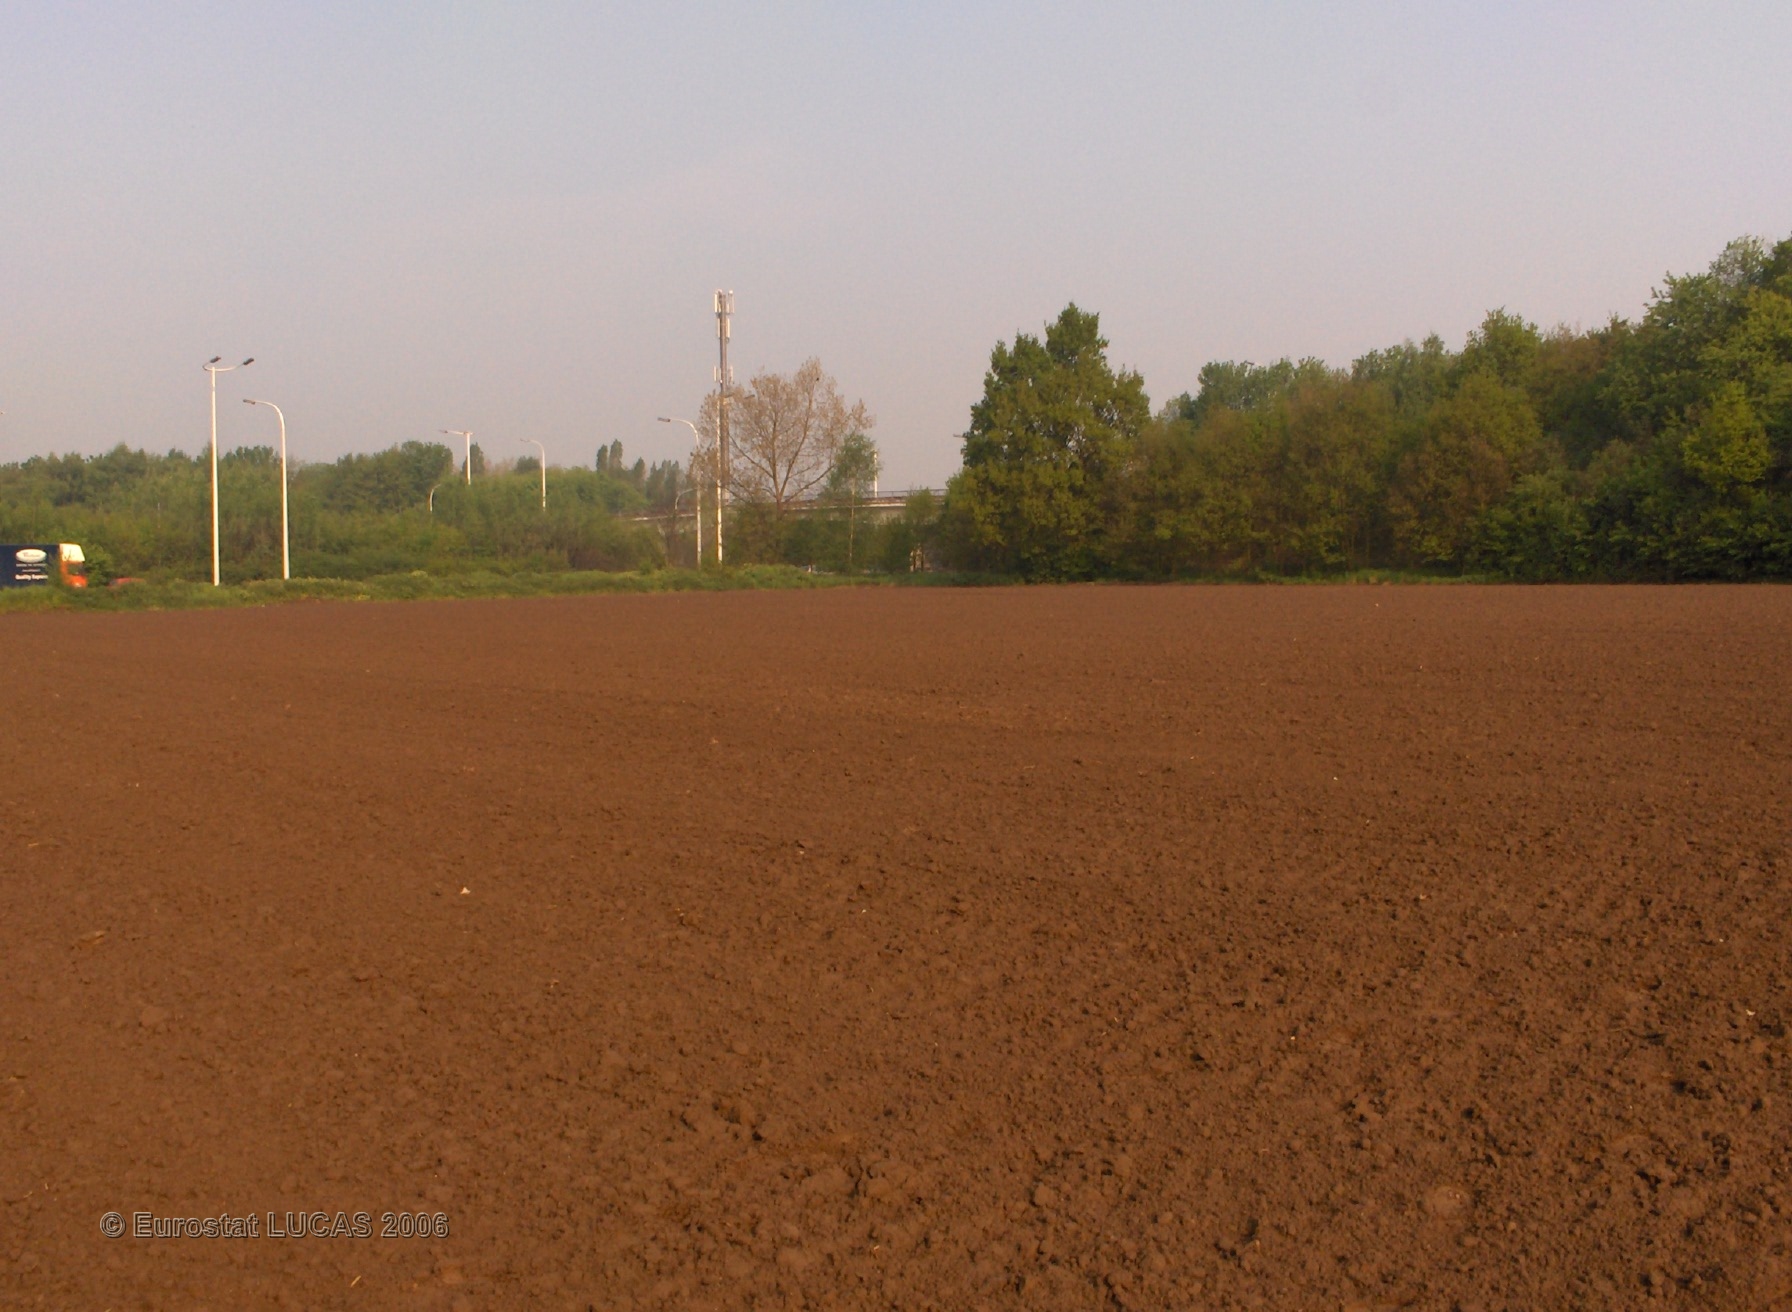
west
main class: Cropland
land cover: Maize
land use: Agriculture (excluding fallow land and kitchen gardens)
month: May
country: BE
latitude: 51.0940
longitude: 4.4412
